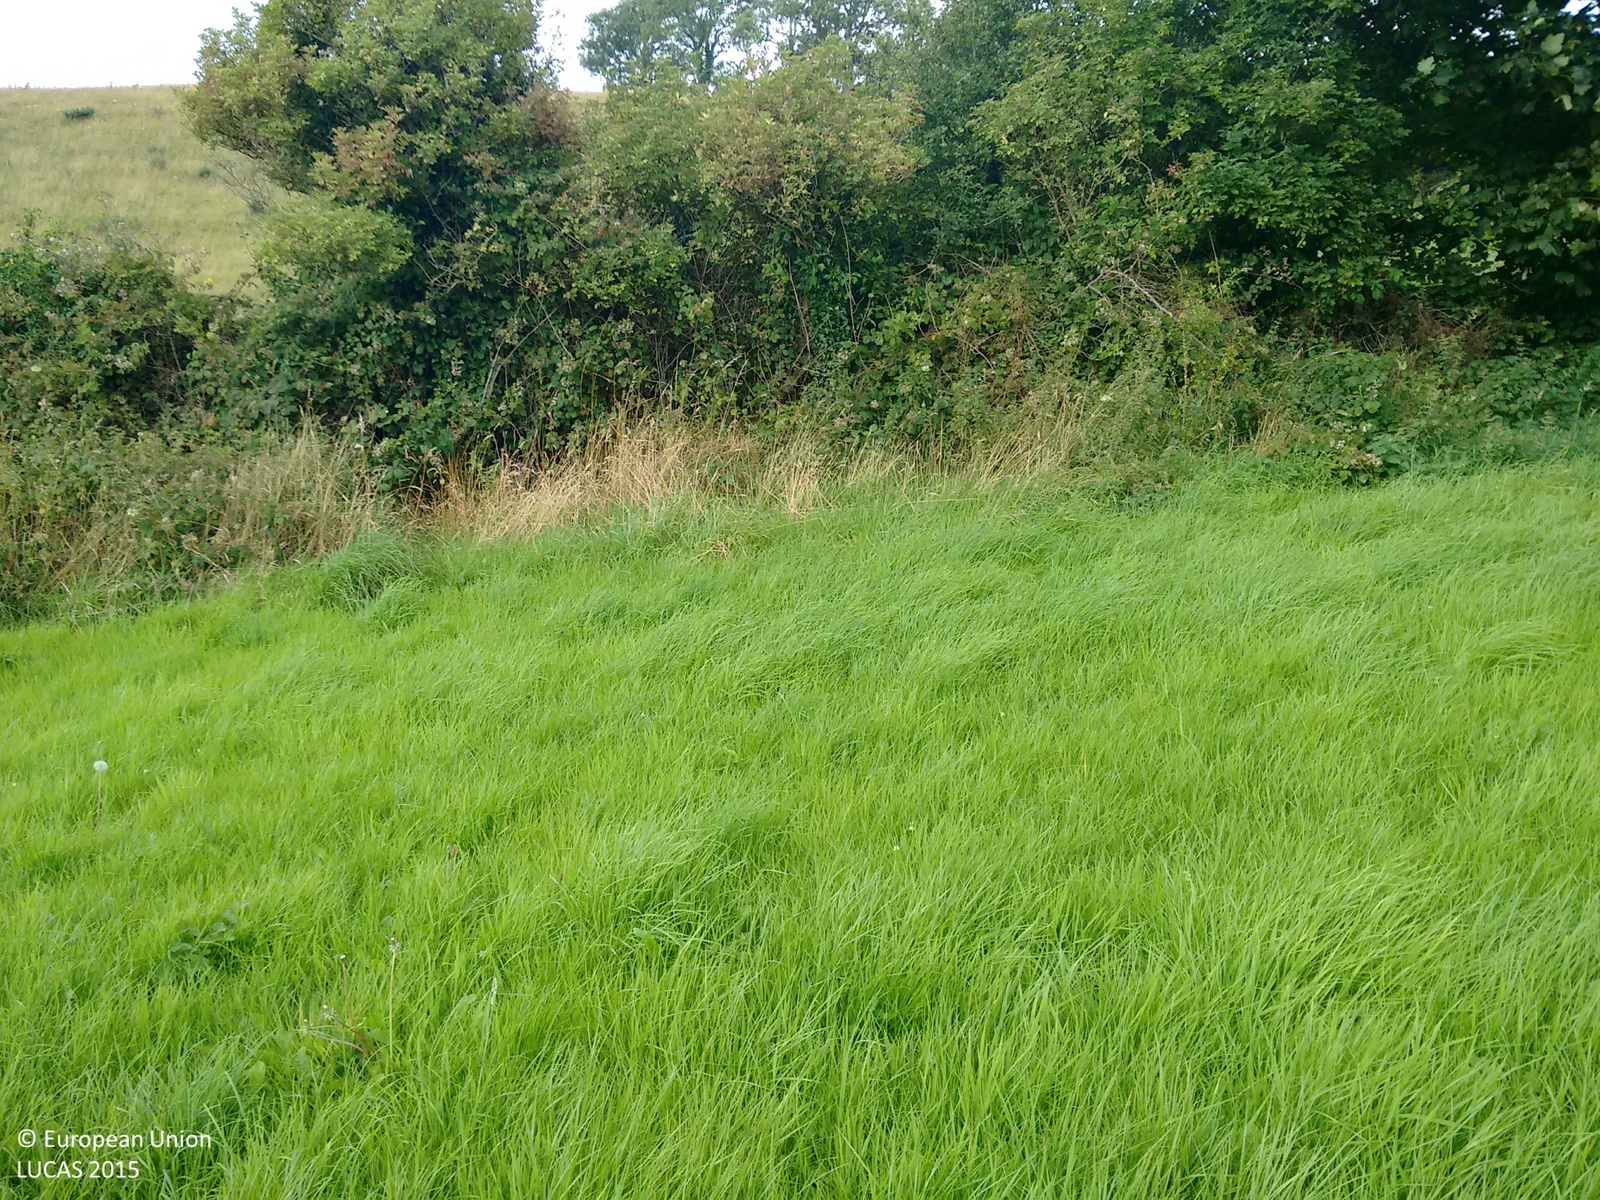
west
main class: Grassland
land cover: Grassland without tree/shrub cover
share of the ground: > 75 %
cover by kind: herbaceous plants 100 %
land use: Agriculture (excluding fallow land and kitchen gardens)
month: August
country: GB
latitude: 54.3648
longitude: -5.7243
